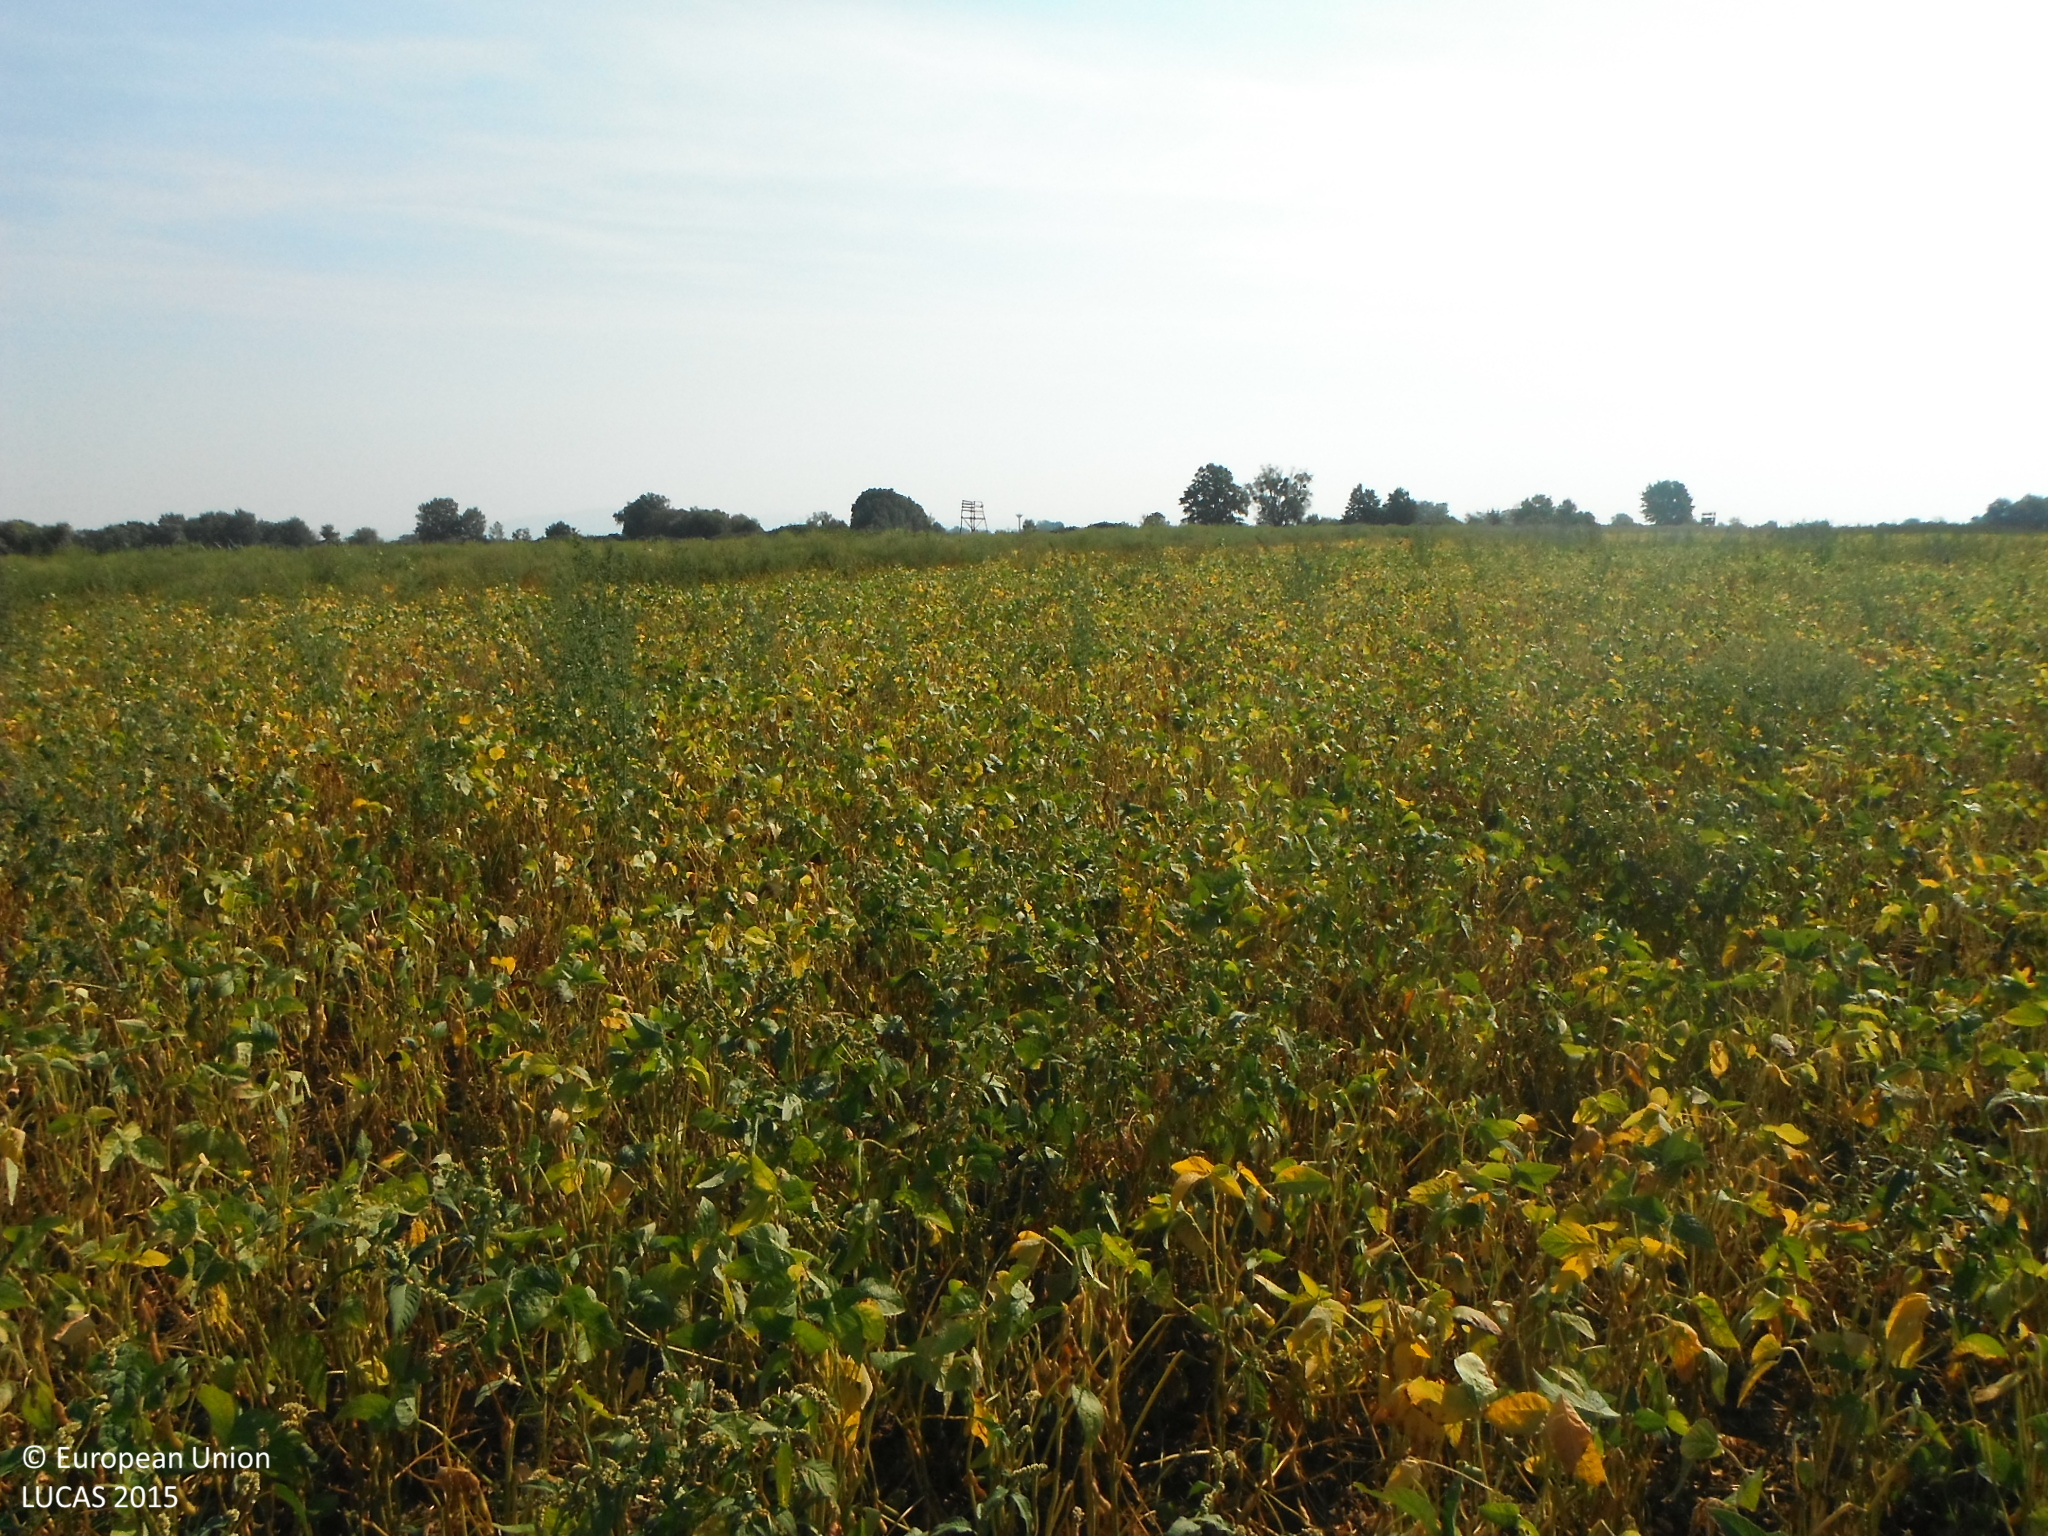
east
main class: Cropland
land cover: Soya
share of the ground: > 75 %
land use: Agriculture (excluding fallow land and kitchen gardens)
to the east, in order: Soya; Grassland without tree/shrub cover; Ditches and canals; Grassland without tree/shrub cover; Other bare soil
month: August
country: SK
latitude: 48.5223
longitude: 22.0647
